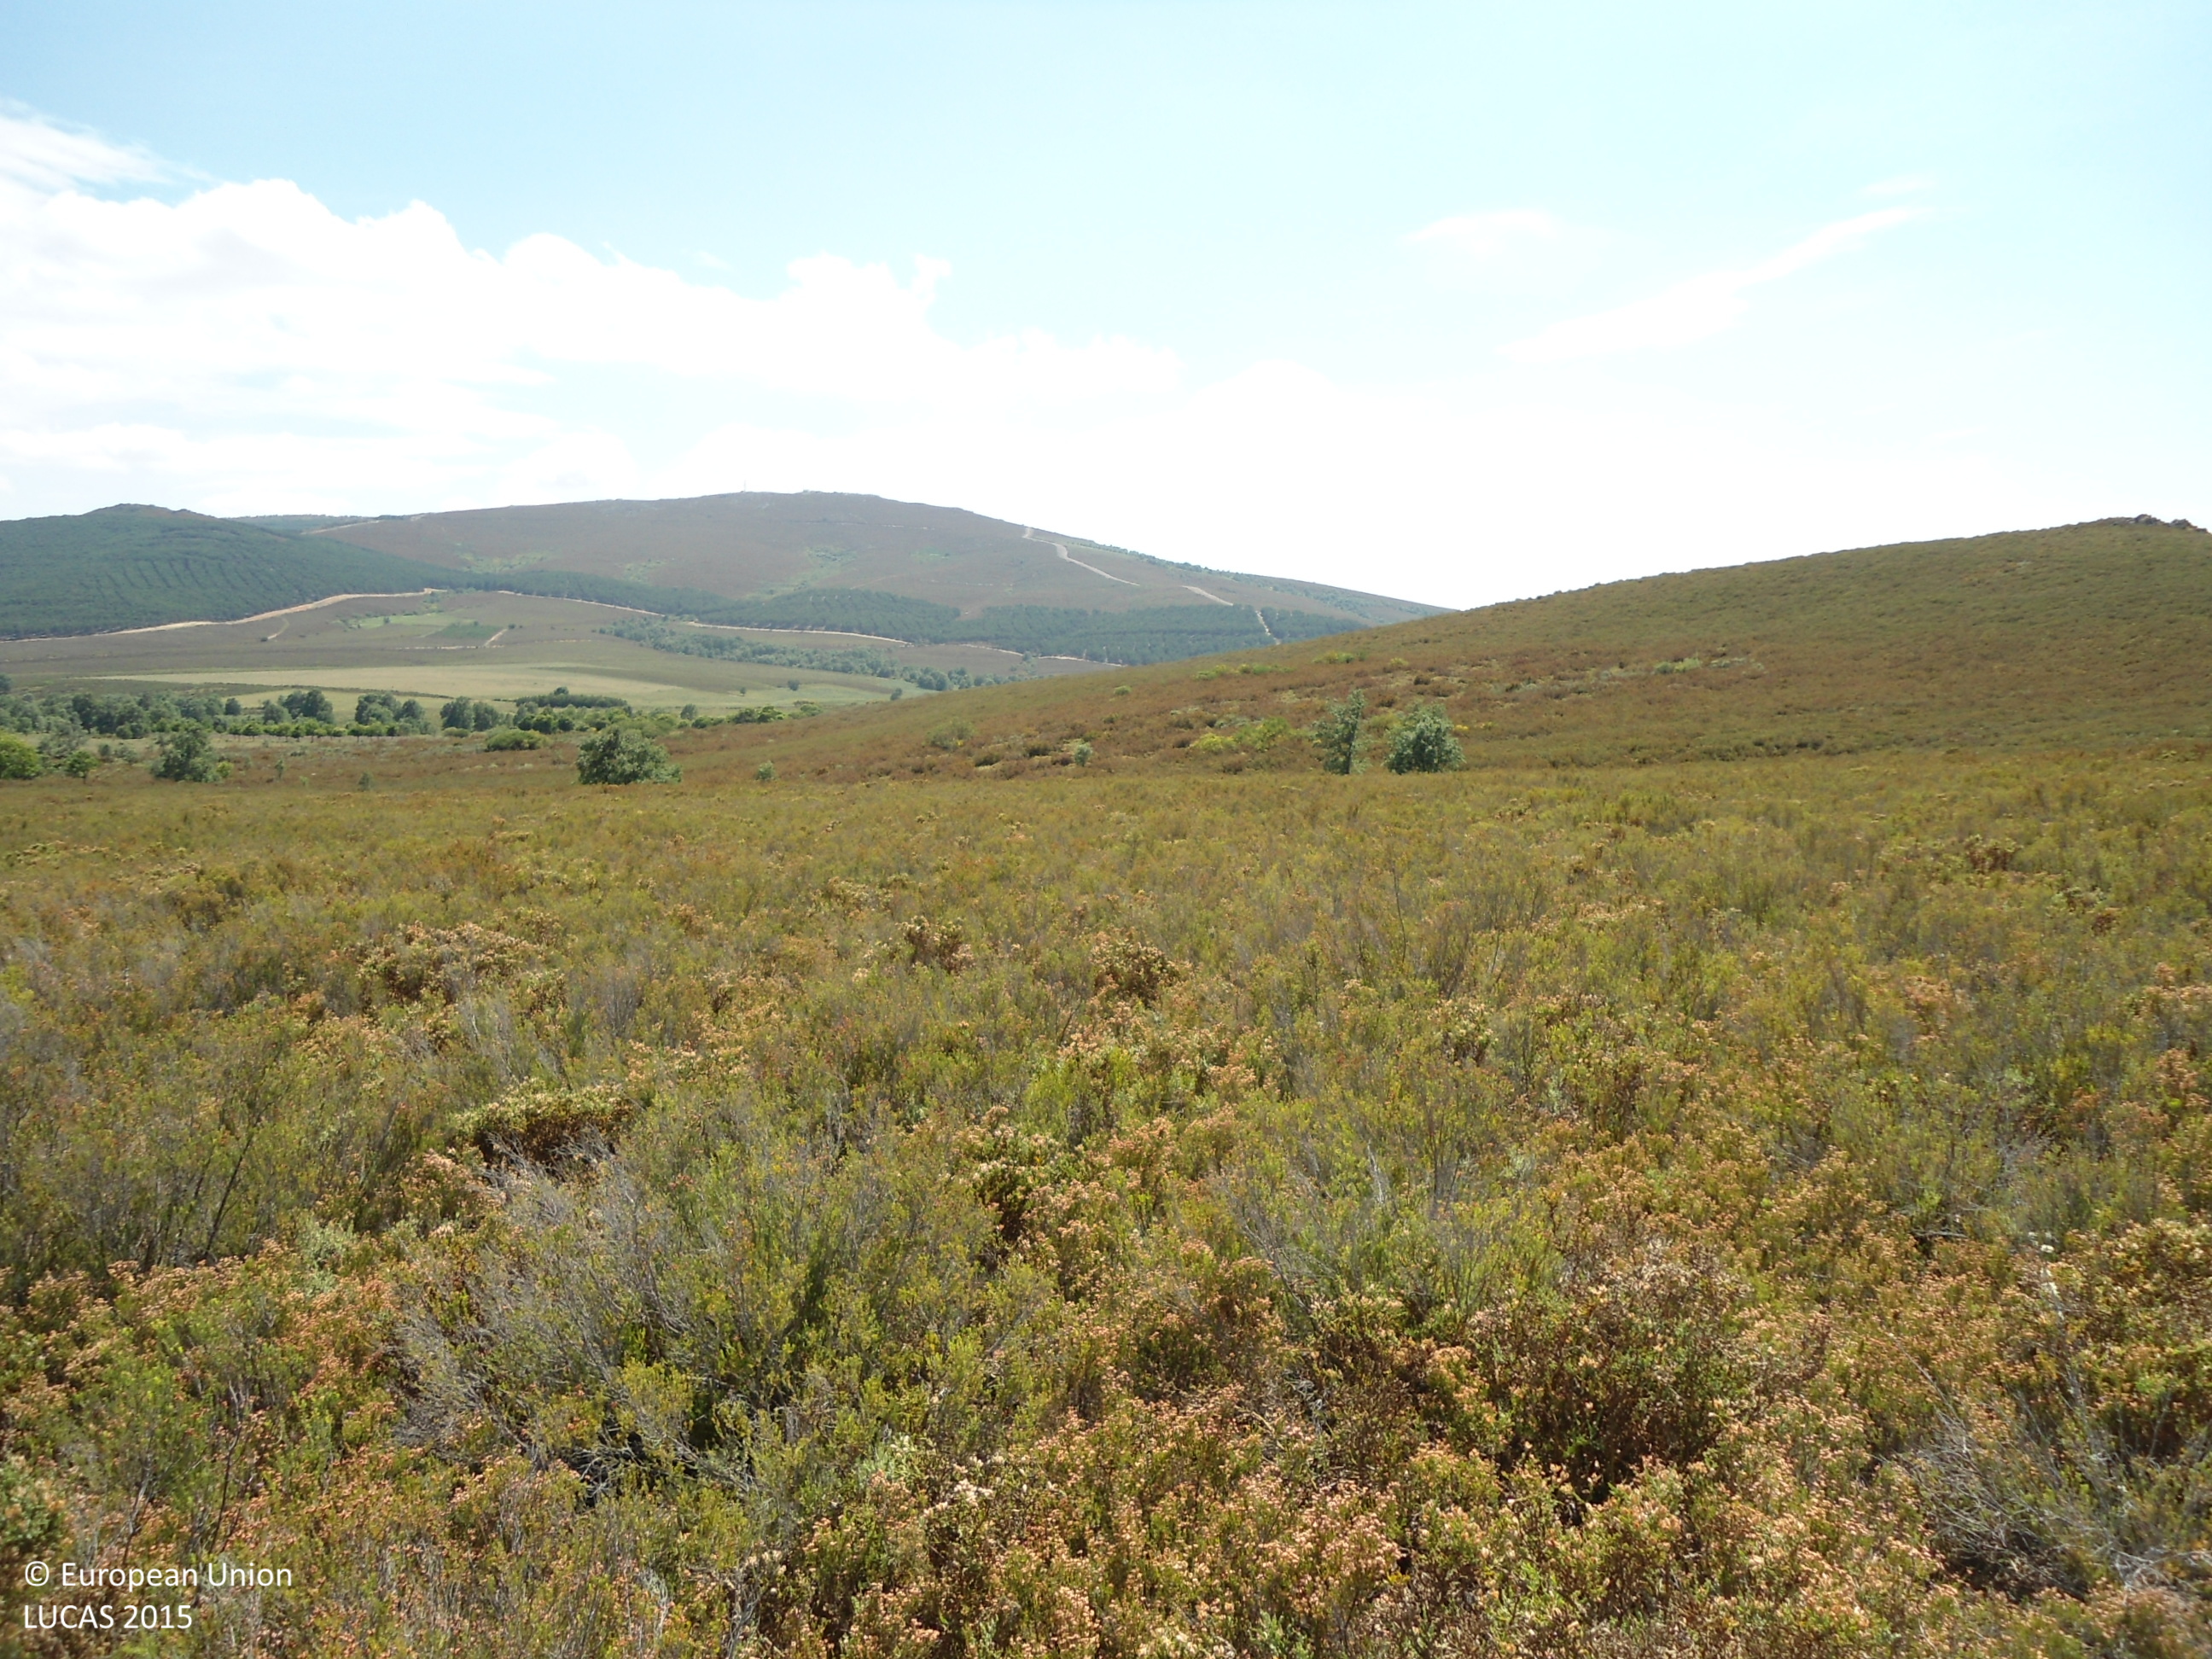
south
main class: Shrubland
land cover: Shrubland without tree cover
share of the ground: > 75 %
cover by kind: shrubs 95 %, consolidated bare surface 5 %
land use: Semi-natural and natural areas not in use
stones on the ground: > 50 %
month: June
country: ES
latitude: 42.1409
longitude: -6.5812
